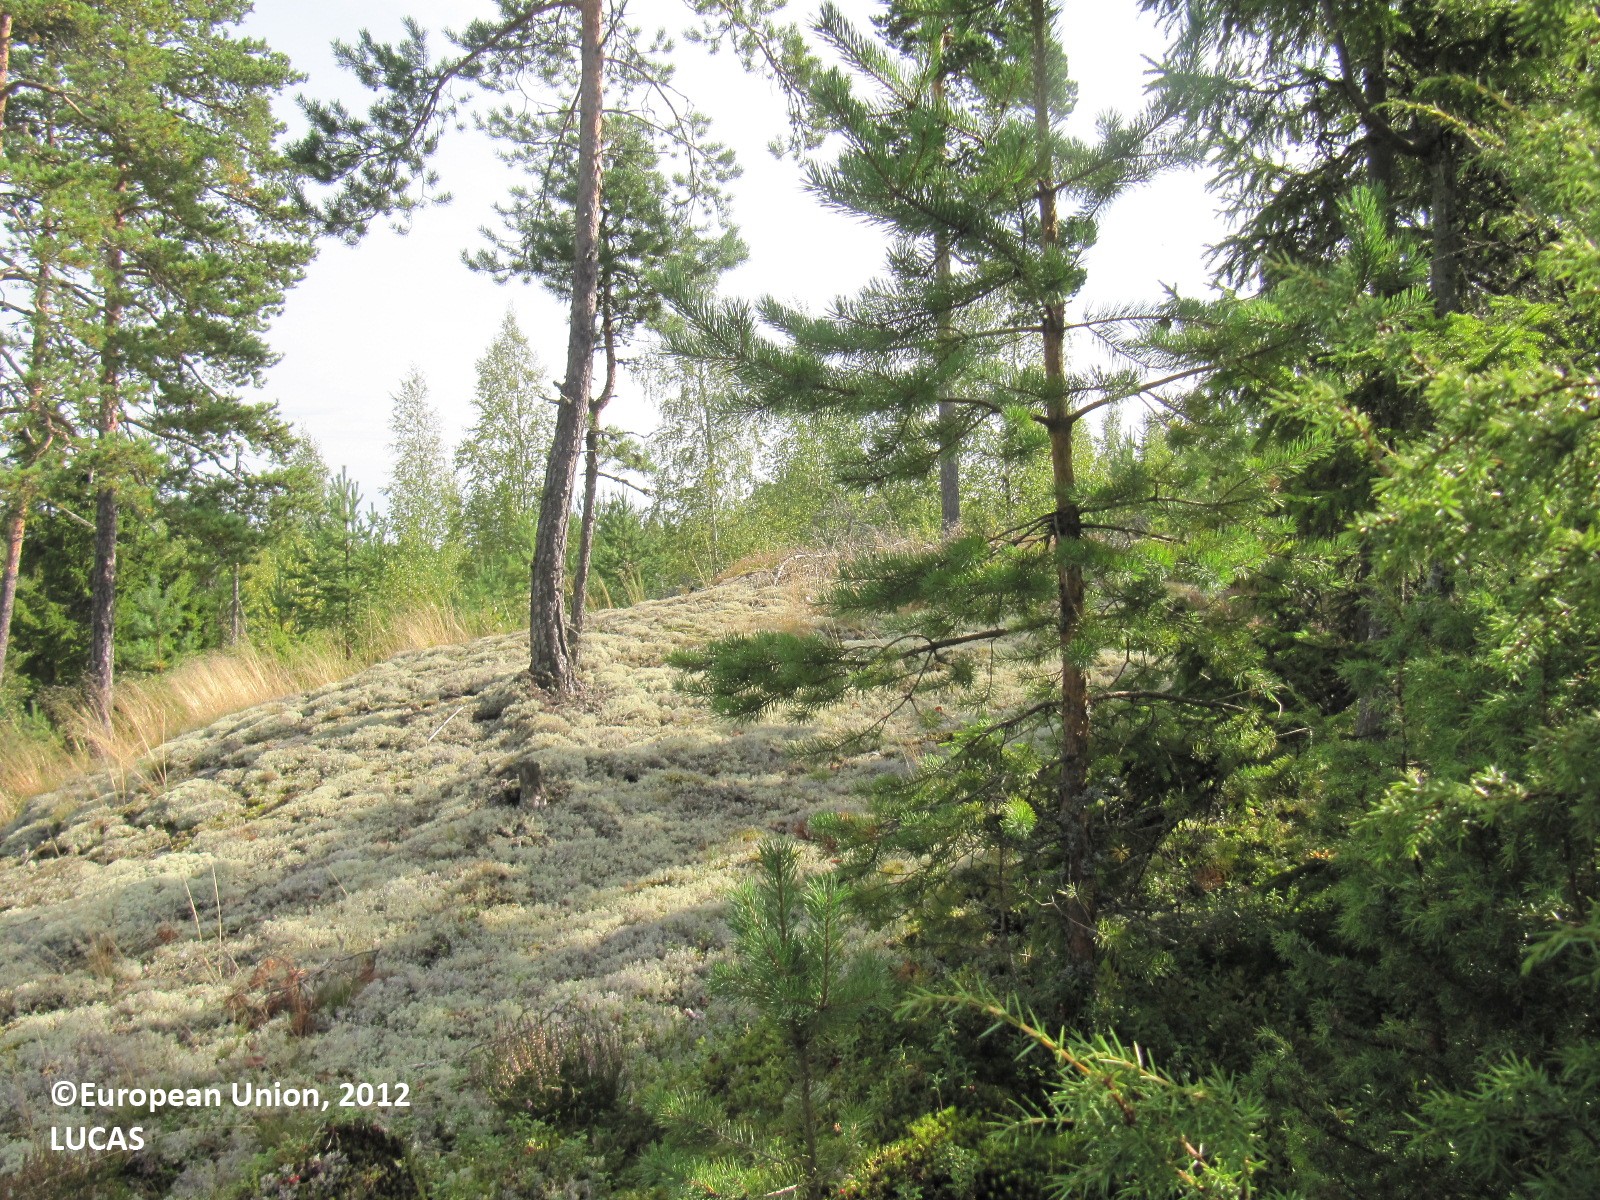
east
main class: Woodland
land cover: Pine dominated mixed woodland
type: boreal forest
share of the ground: 25 - 50 %
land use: Forestry
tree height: > 5 m
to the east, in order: Pine dominated mixed woodland; Ditches and canals; Electric lines; Grass margins; Paved roads, cycling and walking lanes; Shrubland with sparse tree cover; Ditches and canals; Pine dominated mixed woodland
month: August
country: FI
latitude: 61.0120
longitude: 22.8918
